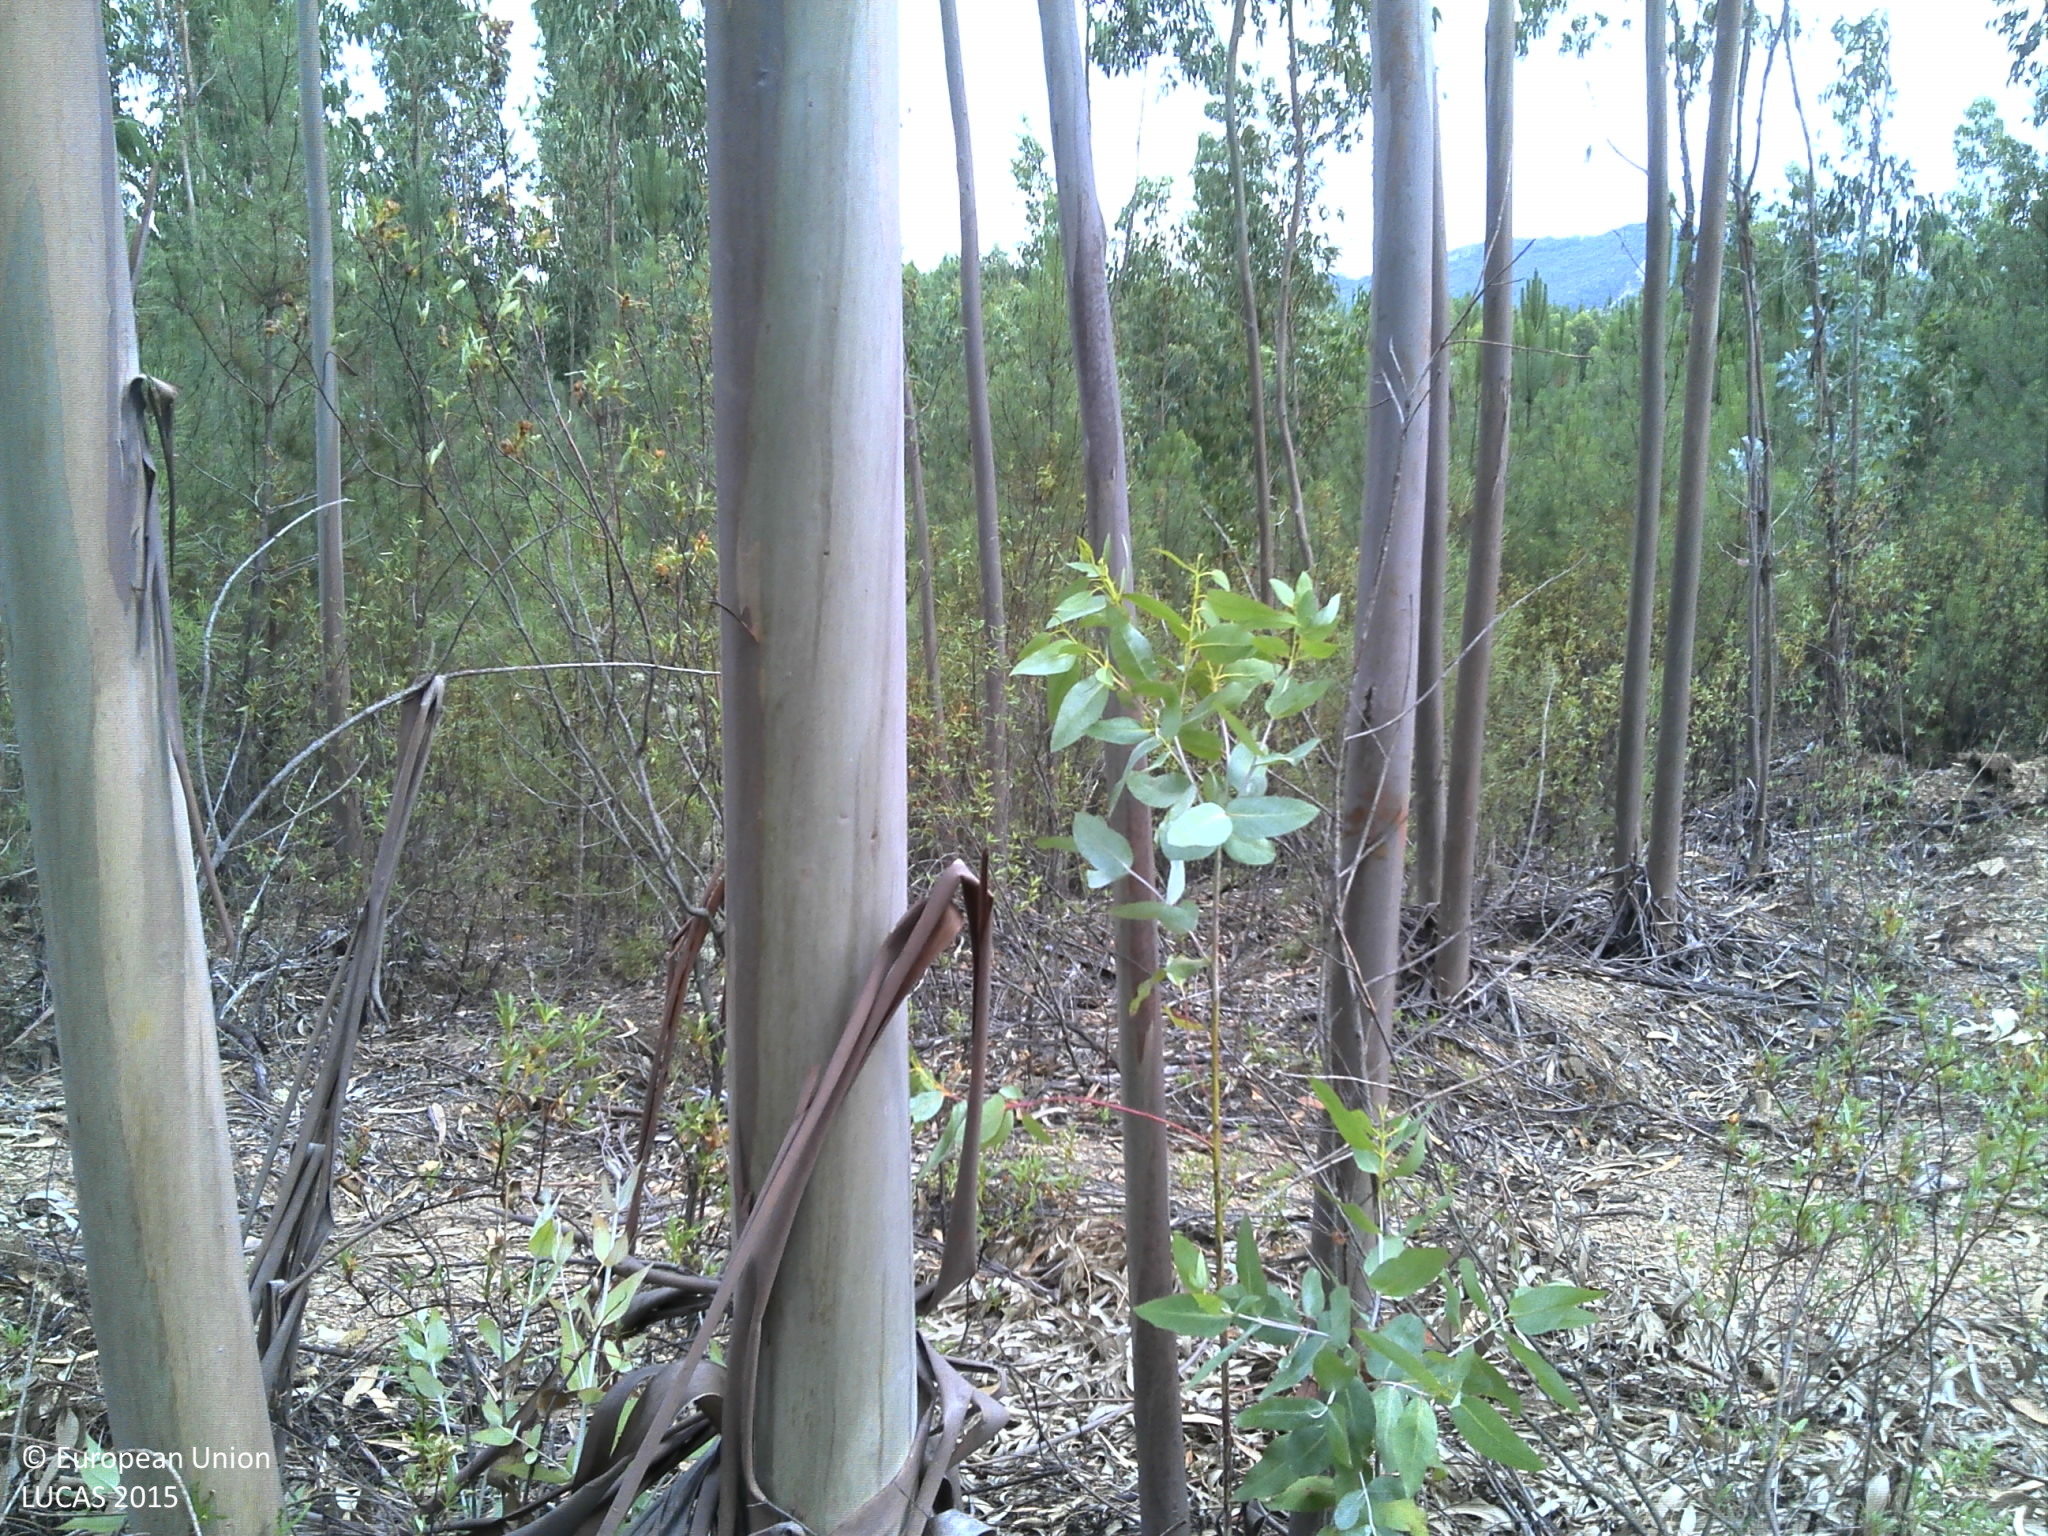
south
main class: Woodland
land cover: Broadleaved woodland
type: exotic forest
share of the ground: 25 - 50 %
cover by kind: unconsolidated bare surface 40 %, broadleaved forest trees 30 %, shrubs 30 %
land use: Forestry
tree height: > 5 m
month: July
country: PT
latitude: 39.6807
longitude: -7.9822
